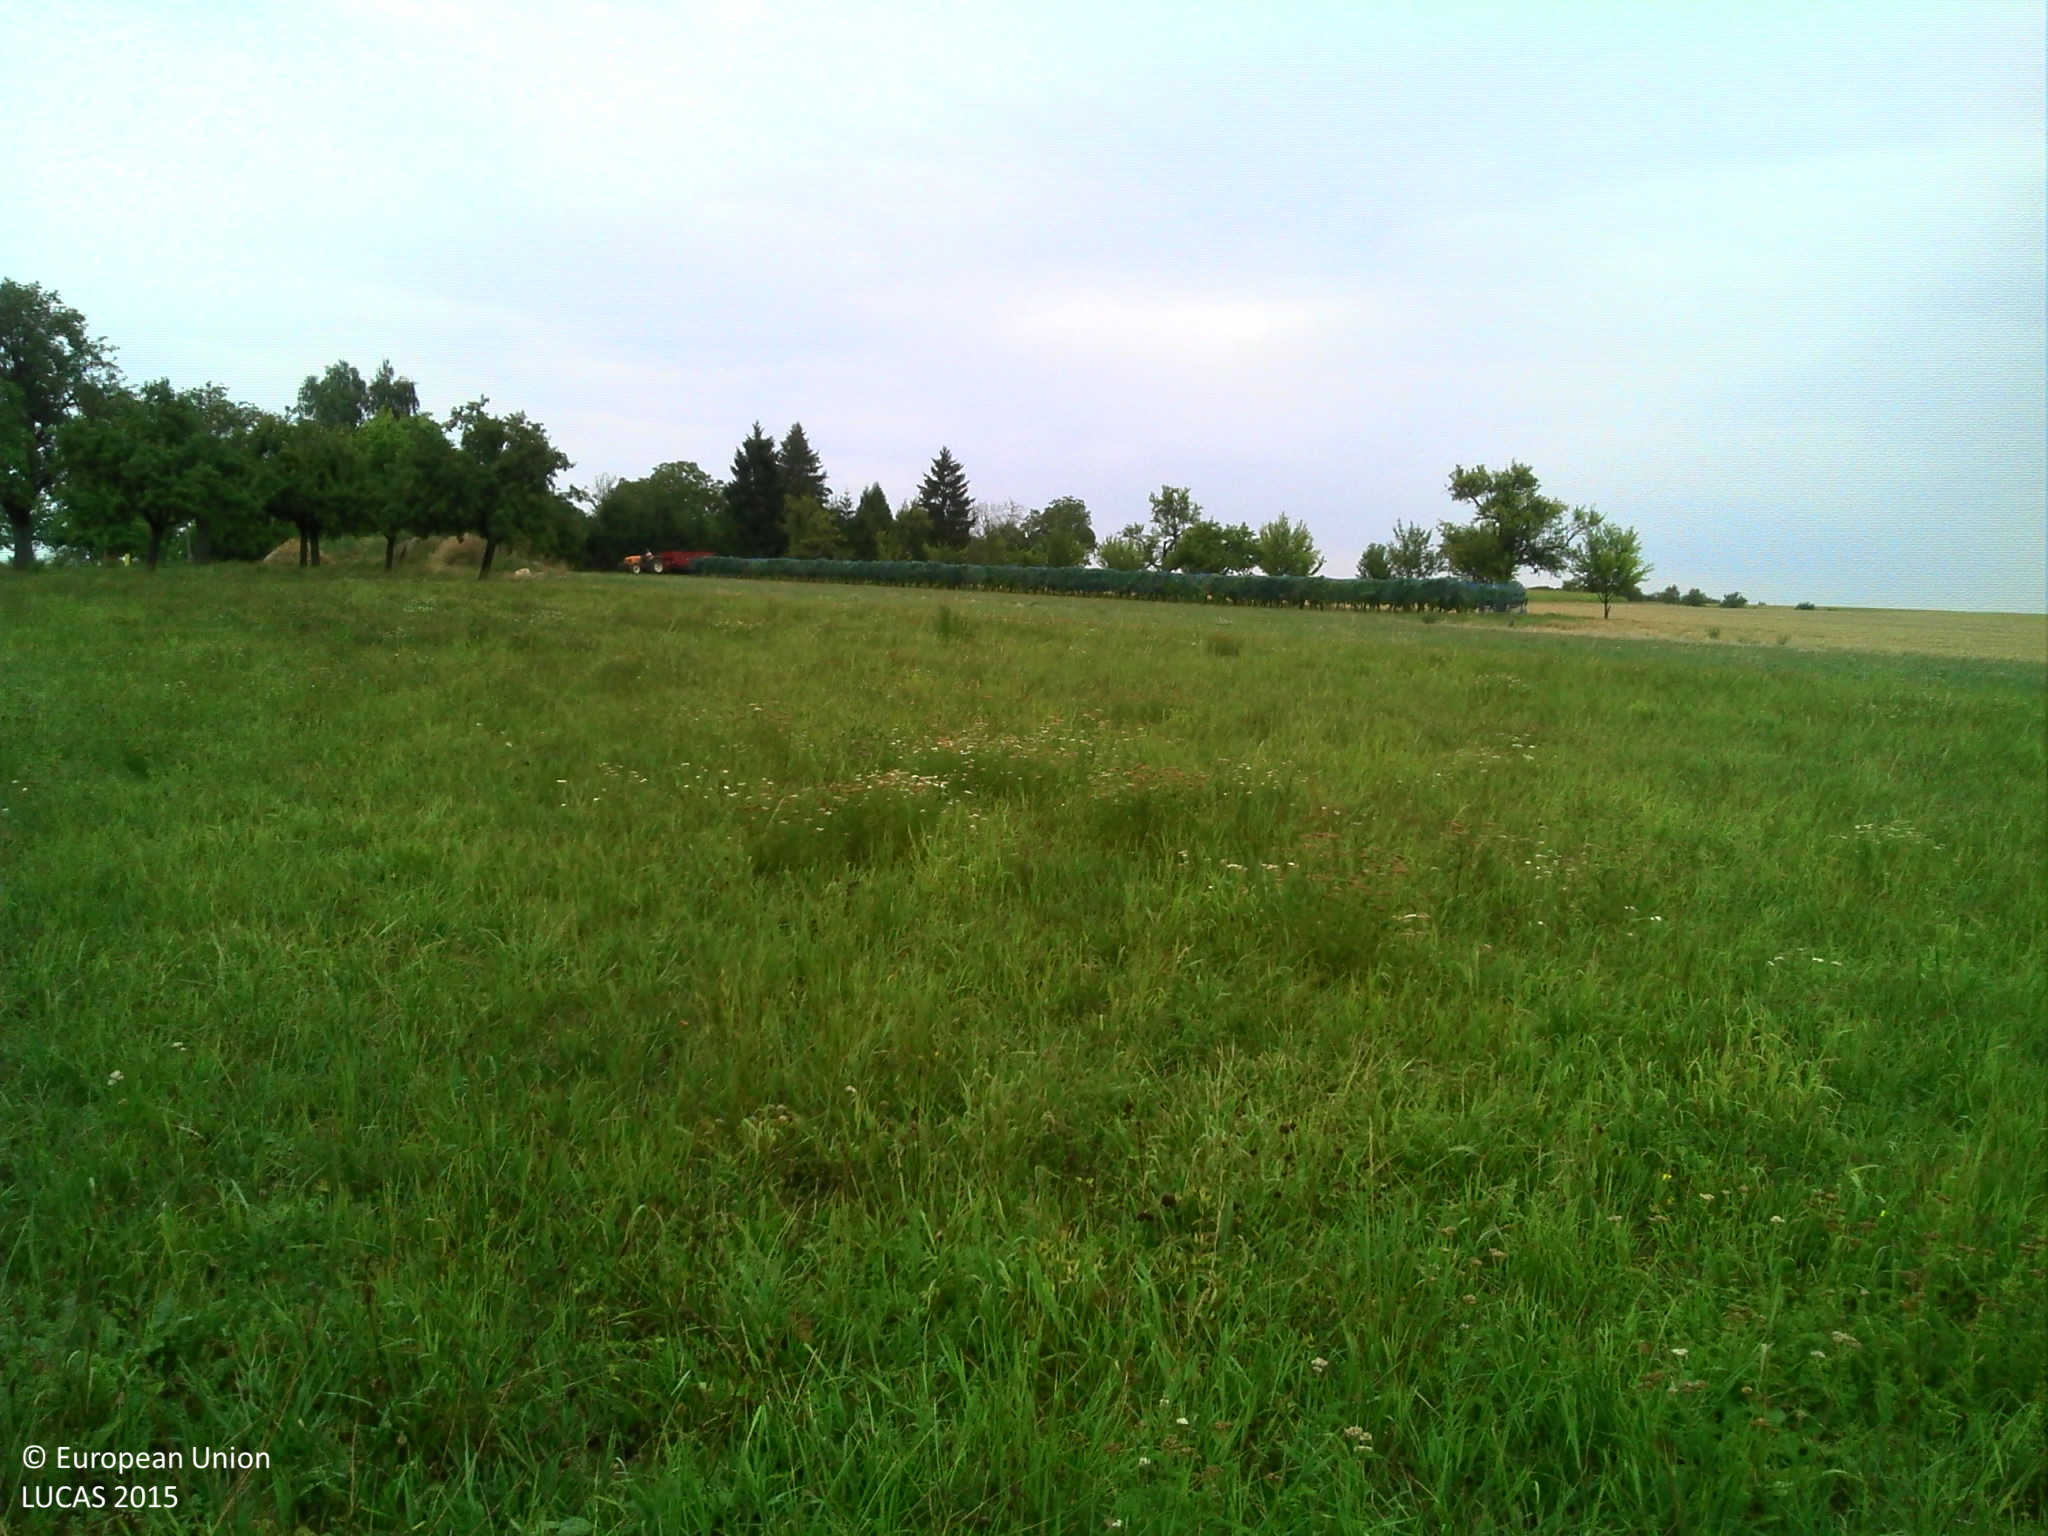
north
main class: Grassland
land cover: Grassland without tree/shrub cover
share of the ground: > 75 %
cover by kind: herbaceous plants 100 %
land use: Agriculture (excluding fallow land and kitchen gardens)
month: August
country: FR
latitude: 48.8823
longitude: 7.6415
